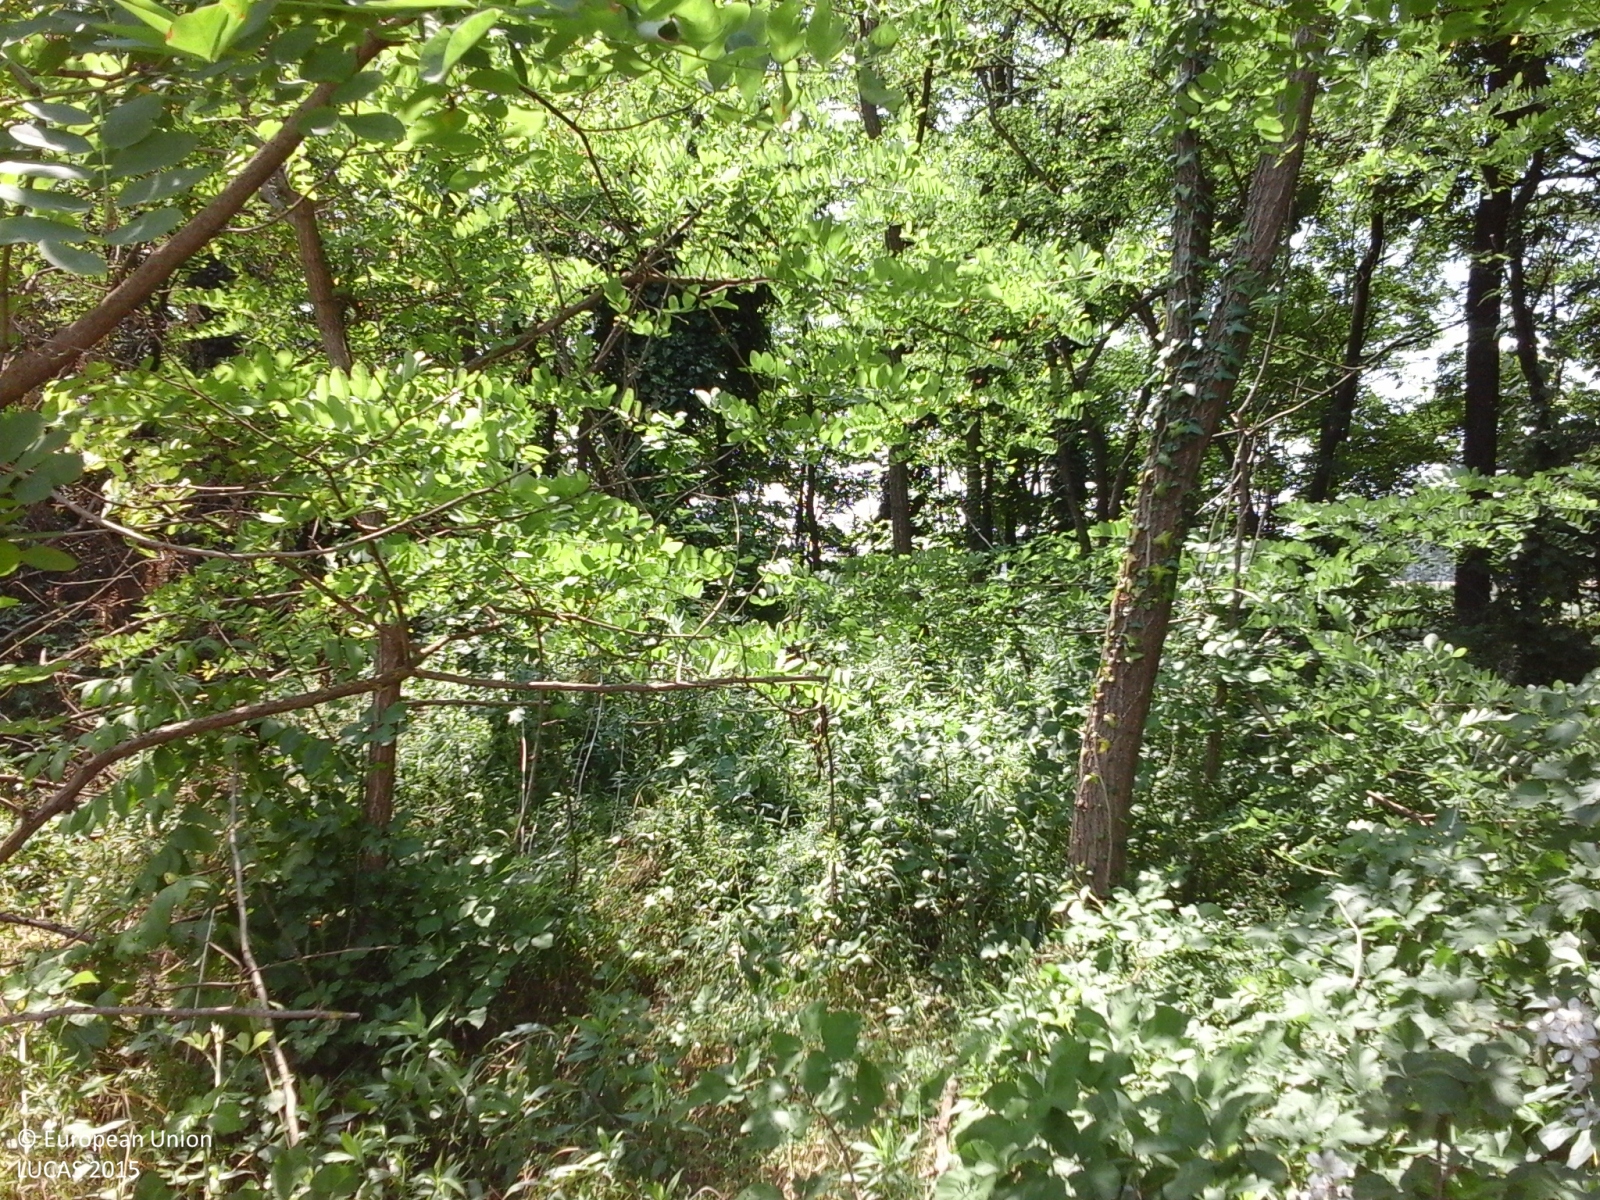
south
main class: Woodland
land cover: Broadleaved woodland
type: thermophilous deciduous forest
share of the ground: > 75 %
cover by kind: broadleaved forest trees 100 %
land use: Semi-natural and natural areas not in use
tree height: > 5 m
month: June
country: IT
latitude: 44.9217
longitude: 7.7618
